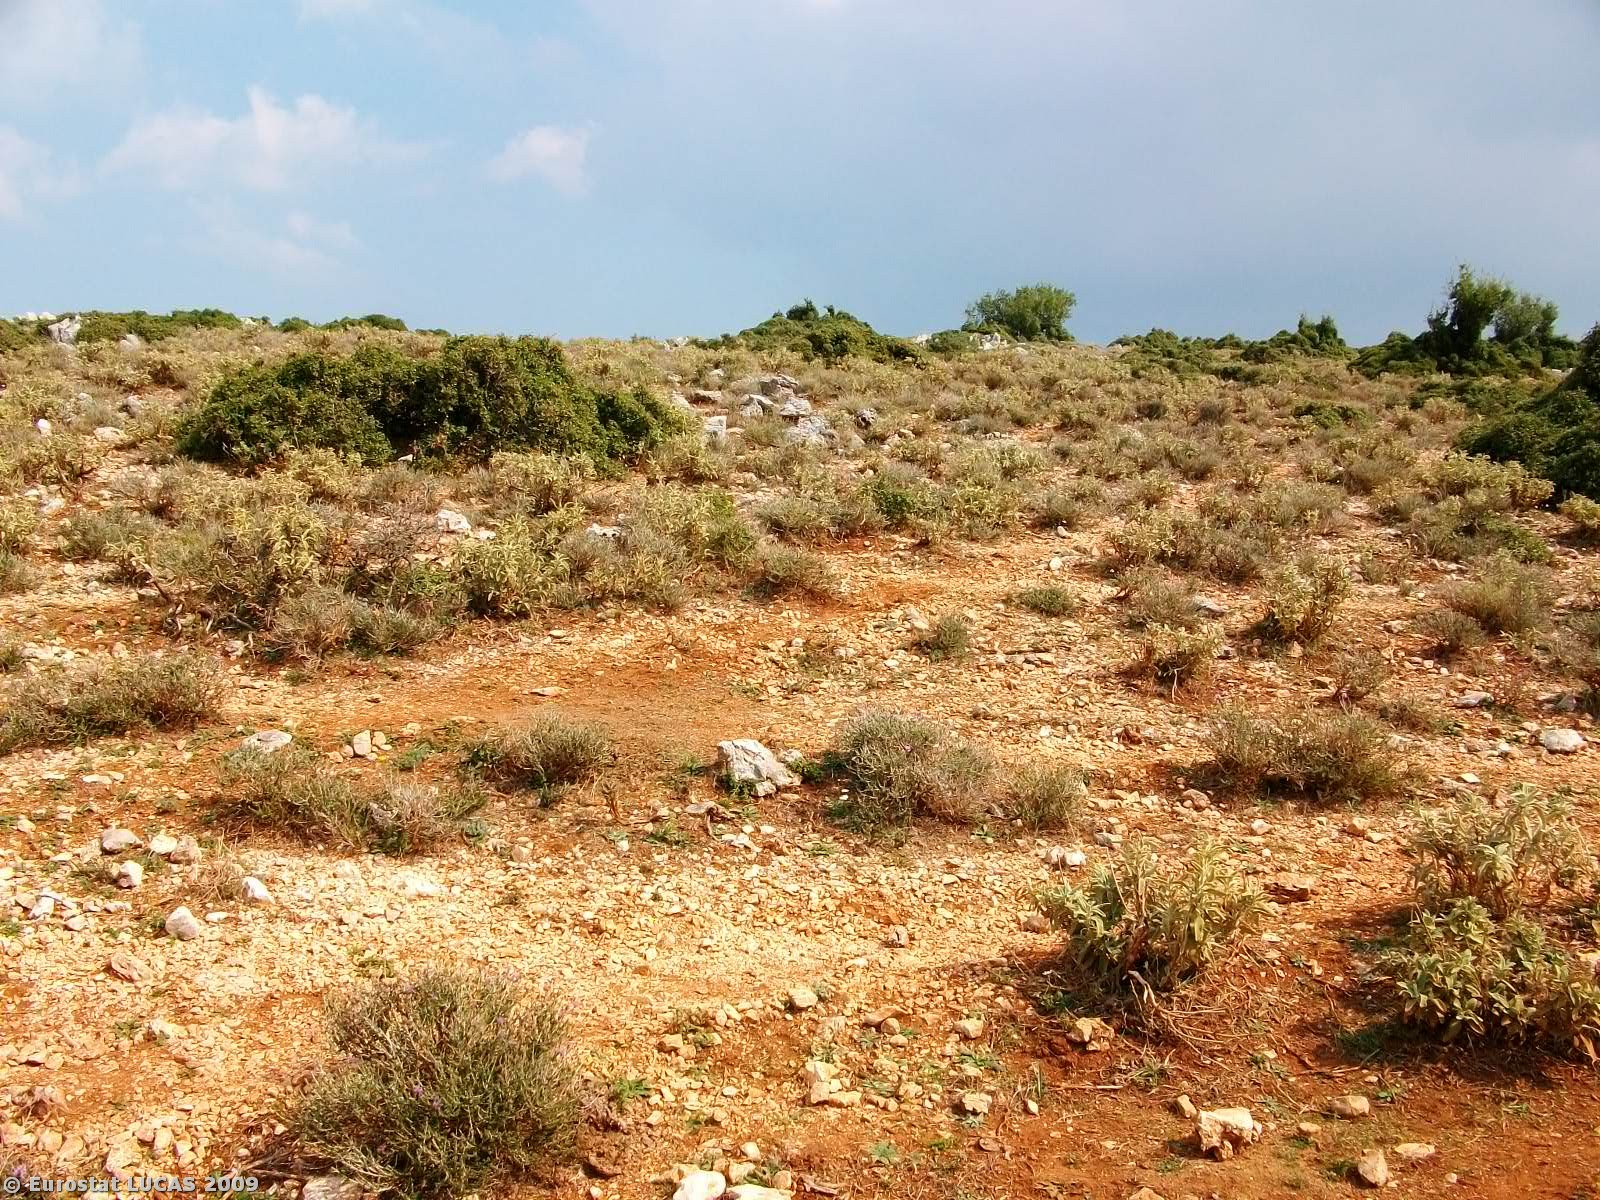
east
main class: Grassland
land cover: Grassland with sparse tree/shrub cover
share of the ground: 25 - 50 %
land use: Agriculture (excluding fallow land and kitchen gardens)
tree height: < 5 m
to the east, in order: Grassland with sparse tree/shrub cover; Shrubland without tree cover; Rock outcrops; Shrubland with sparse tree cover; Grassland with sparse tree/shrub cover
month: October
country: GR
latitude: 39.4196
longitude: 20.4161
